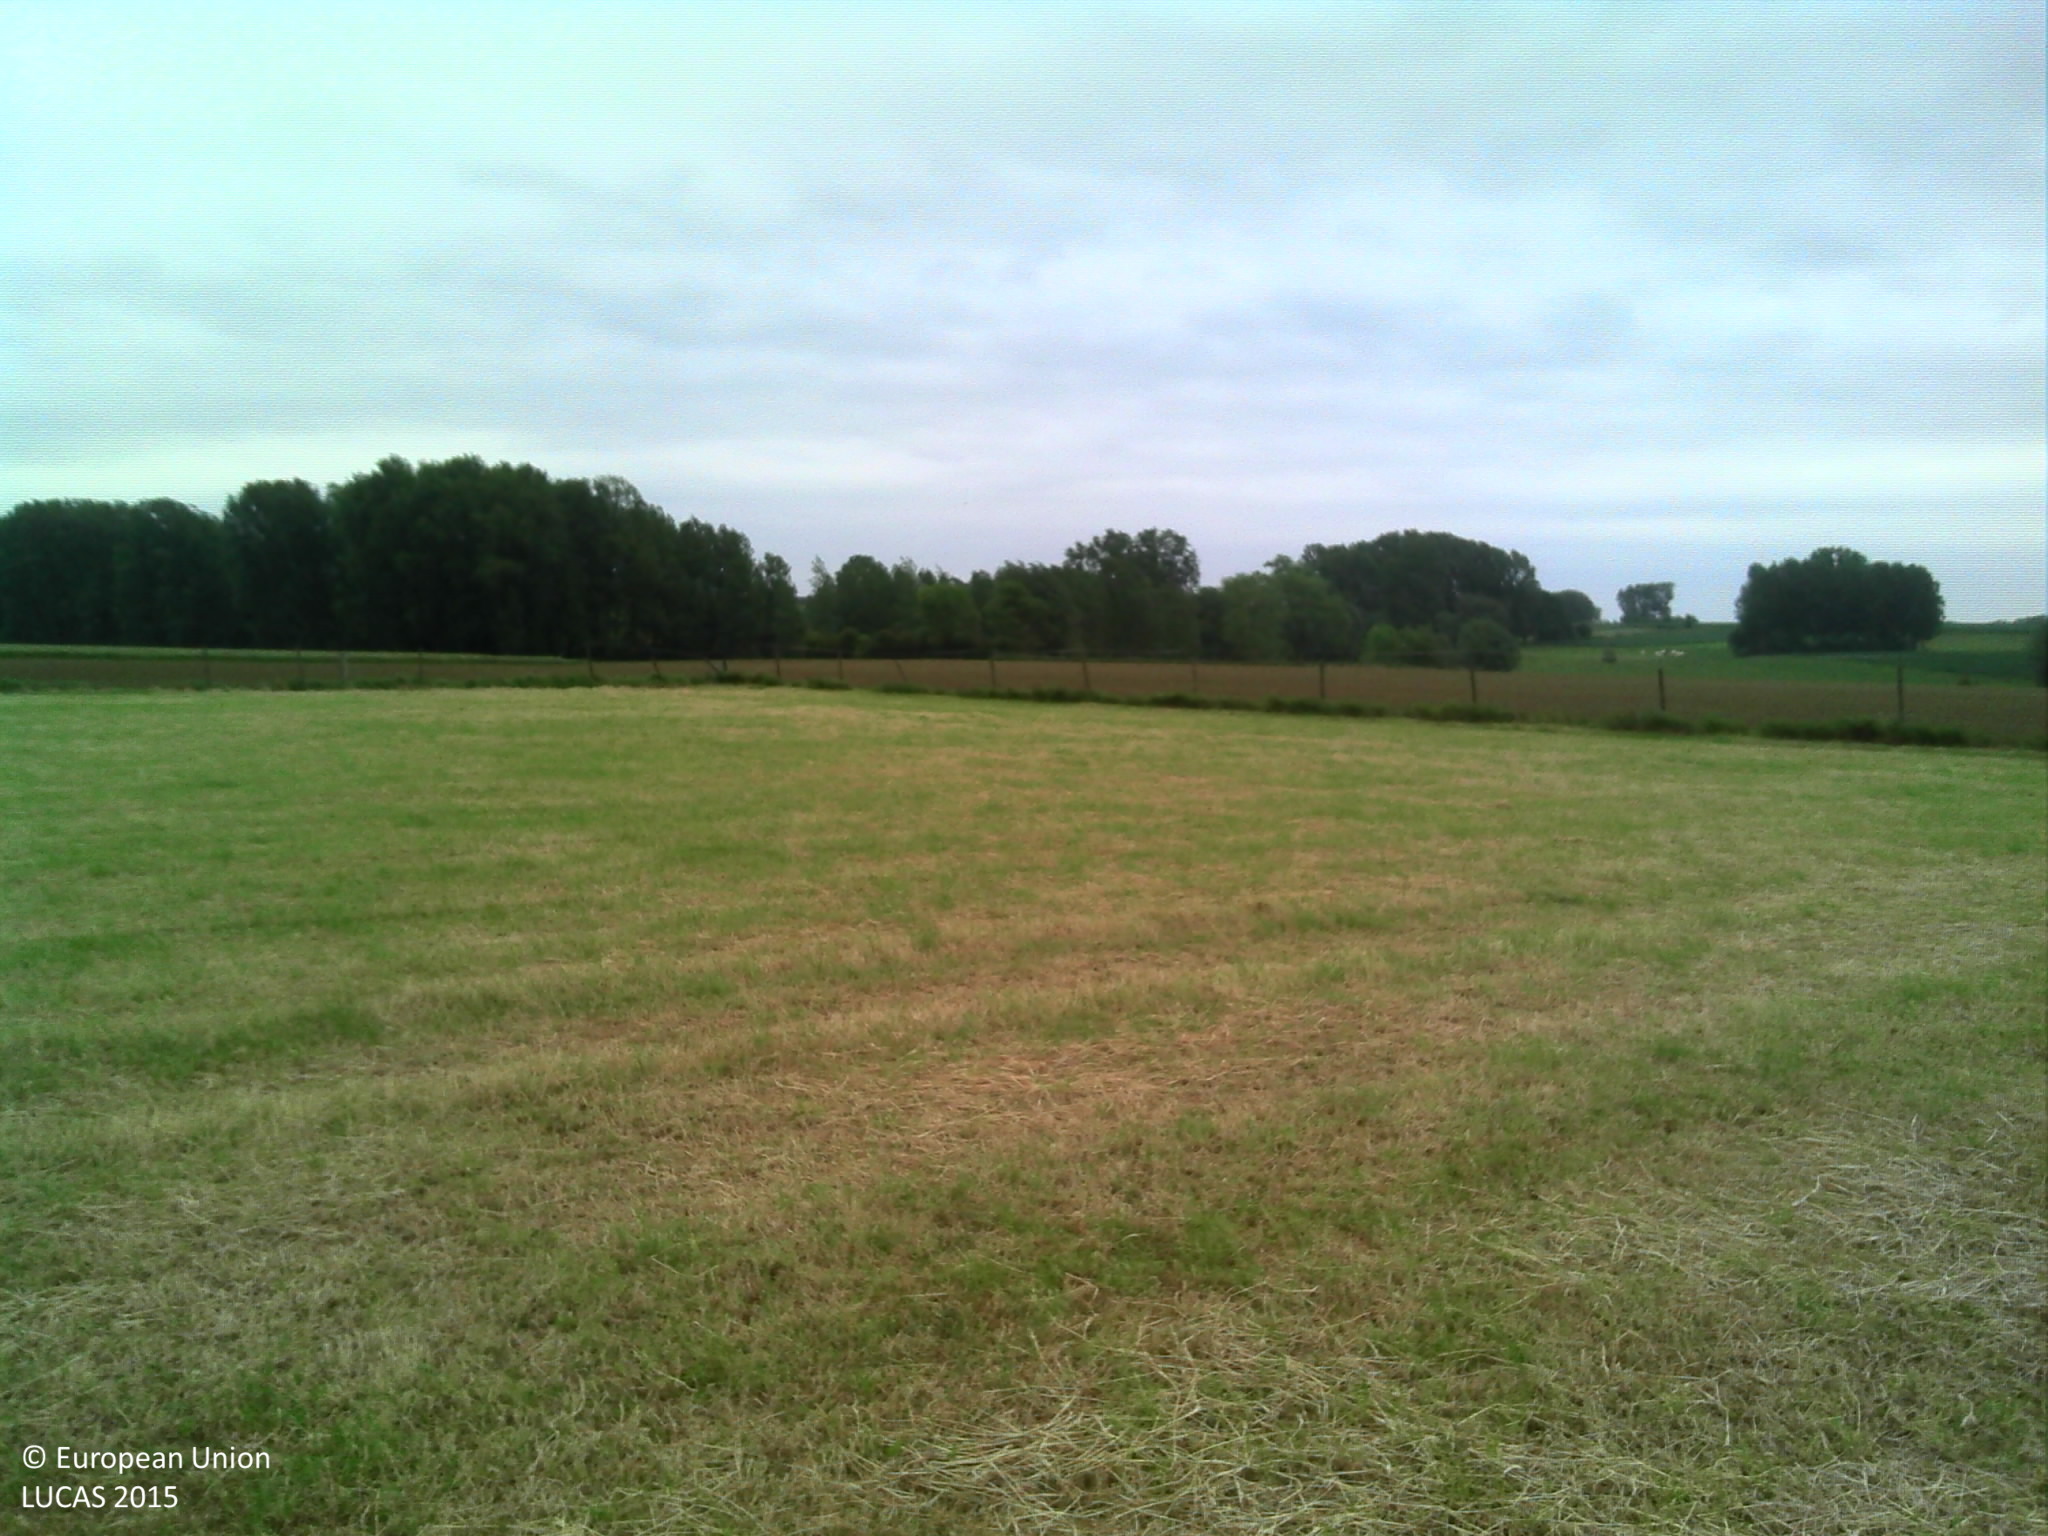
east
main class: Grassland
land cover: Grassland without tree/shrub cover
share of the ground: > 75 %
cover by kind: herbaceous plants 100 %
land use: Agriculture (excluding fallow land and kitchen gardens)
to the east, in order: Grassland without tree/shrub cover; Fences; Maize
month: June
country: BE
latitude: 50.8474
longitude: 3.8436
